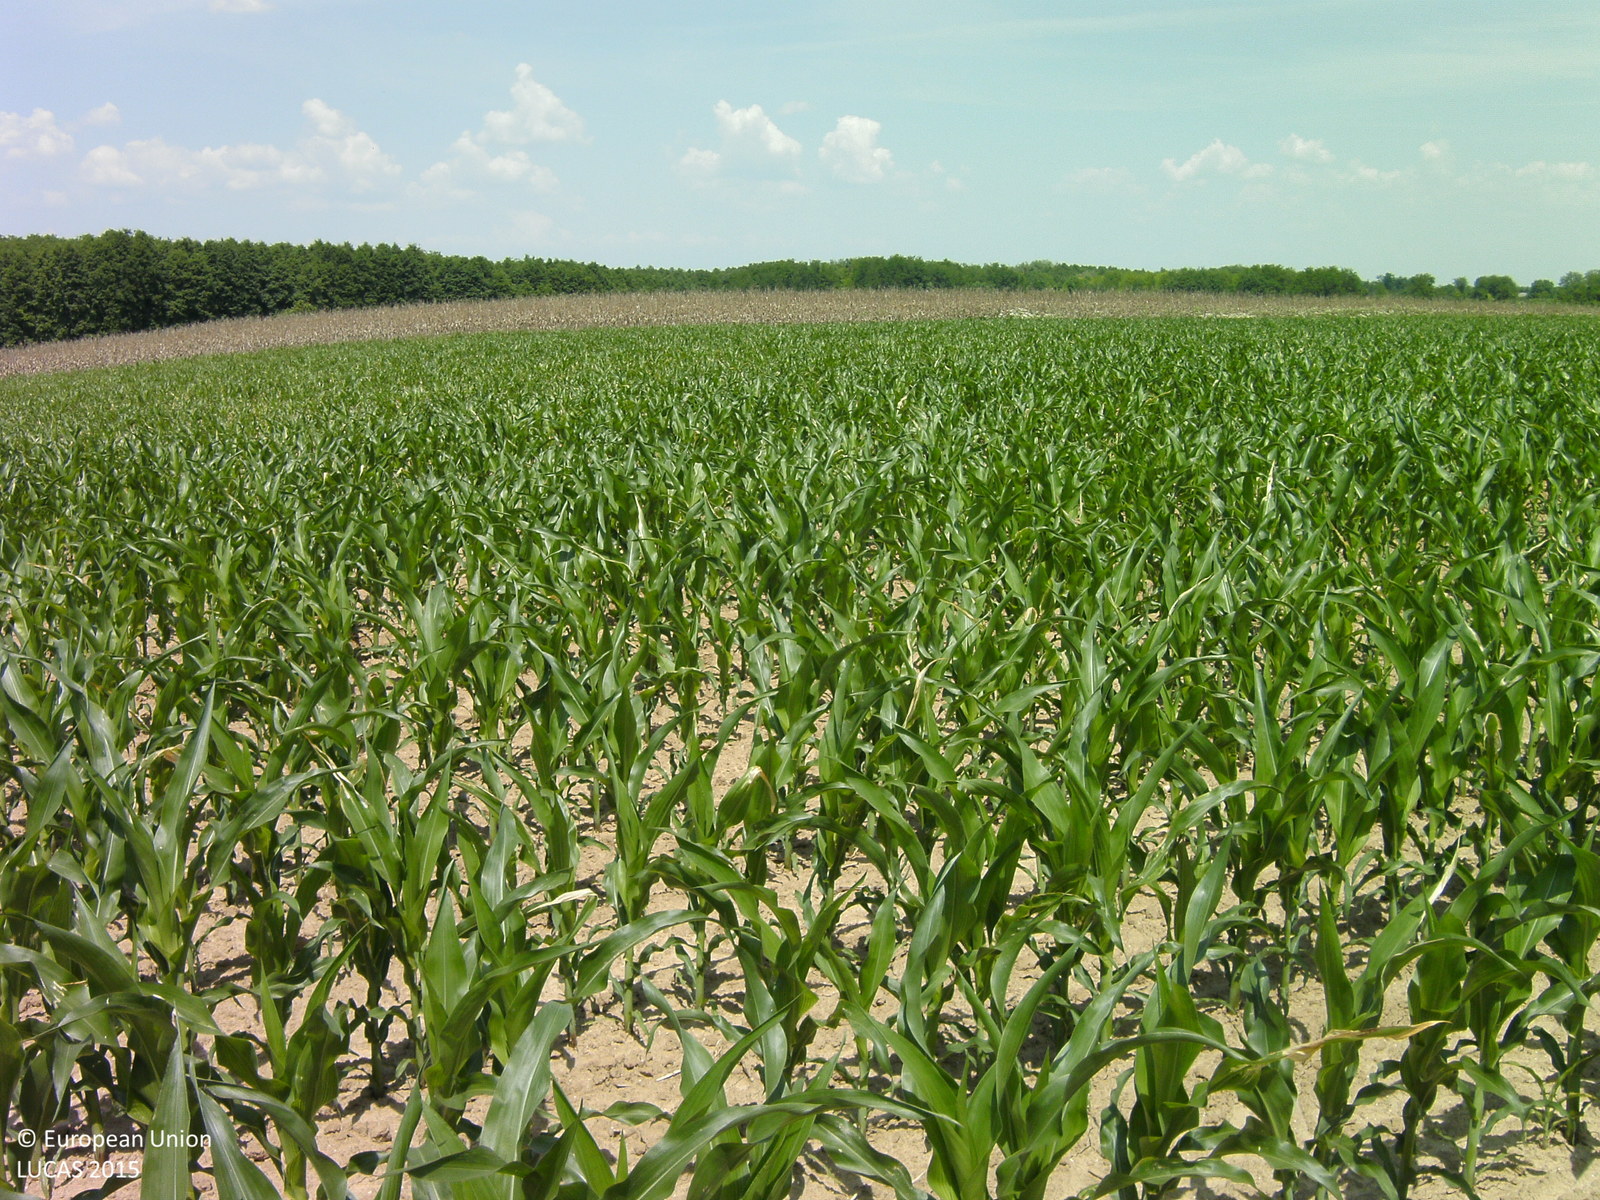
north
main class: Cropland
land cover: Maize
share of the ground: 25 - 50 %
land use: Agriculture (excluding fallow land and kitchen gardens)
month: June
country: HU
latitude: 46.3996
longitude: 17.6923
